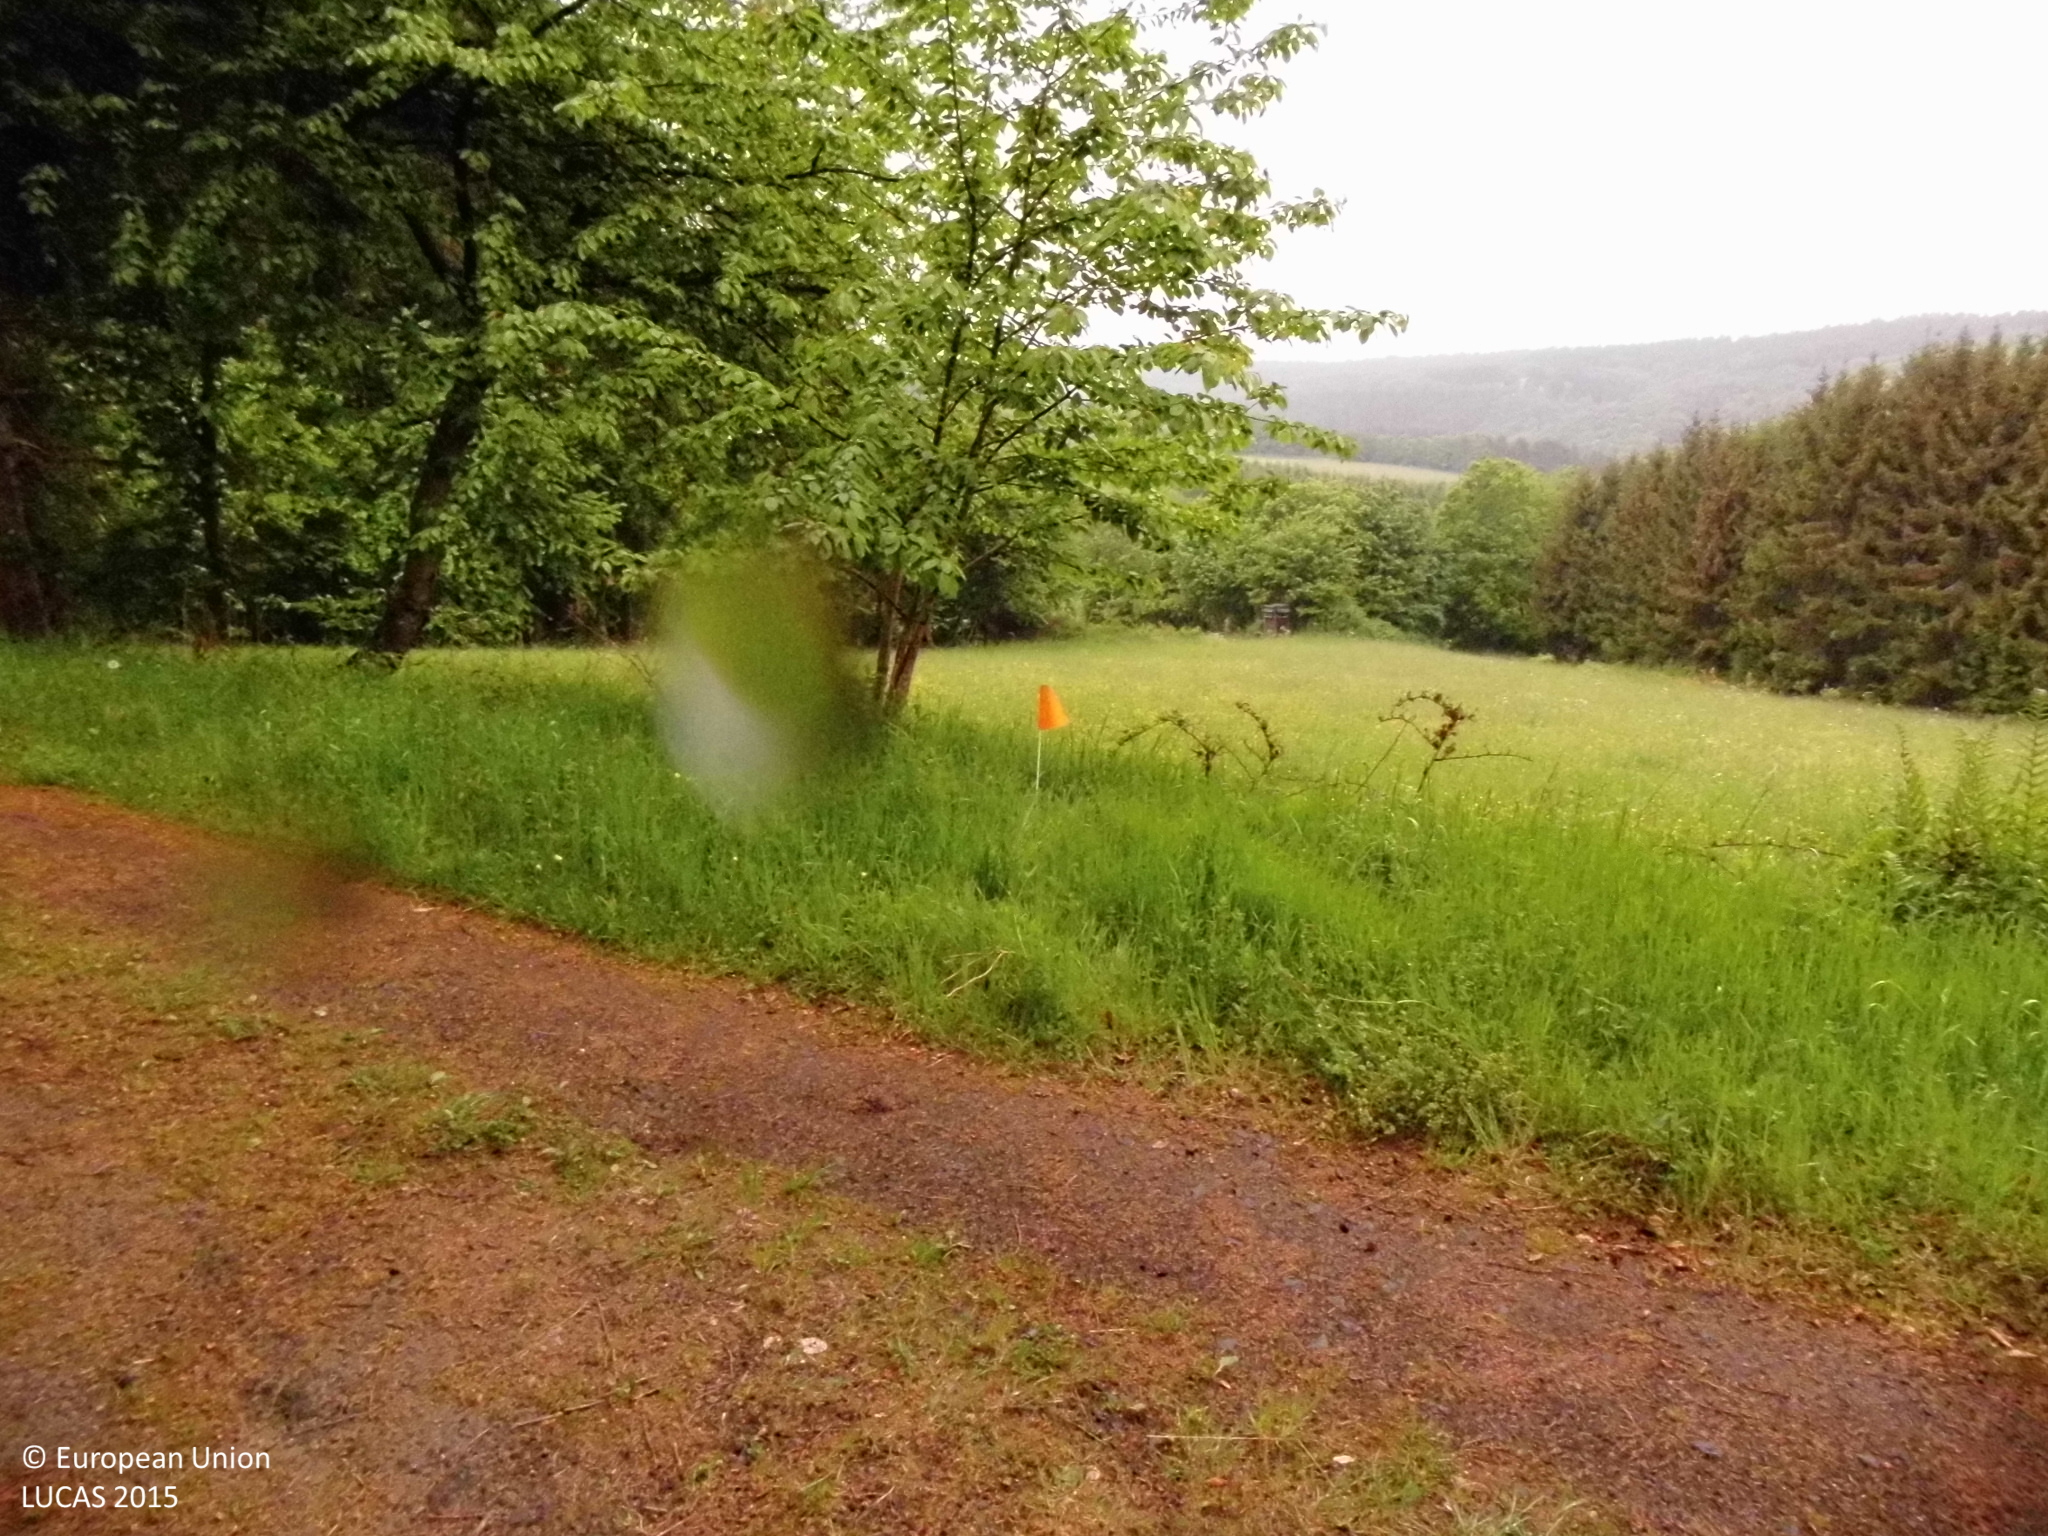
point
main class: Shrubland
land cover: Shrubland with sparse tree cover
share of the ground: > 75 %
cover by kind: herbaceous plants 55 %, shrubs 40 %, broadleaved forest trees 5 %
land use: Semi-natural and natural areas not in use
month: May
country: DE
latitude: 50.6072
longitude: 7.5274
